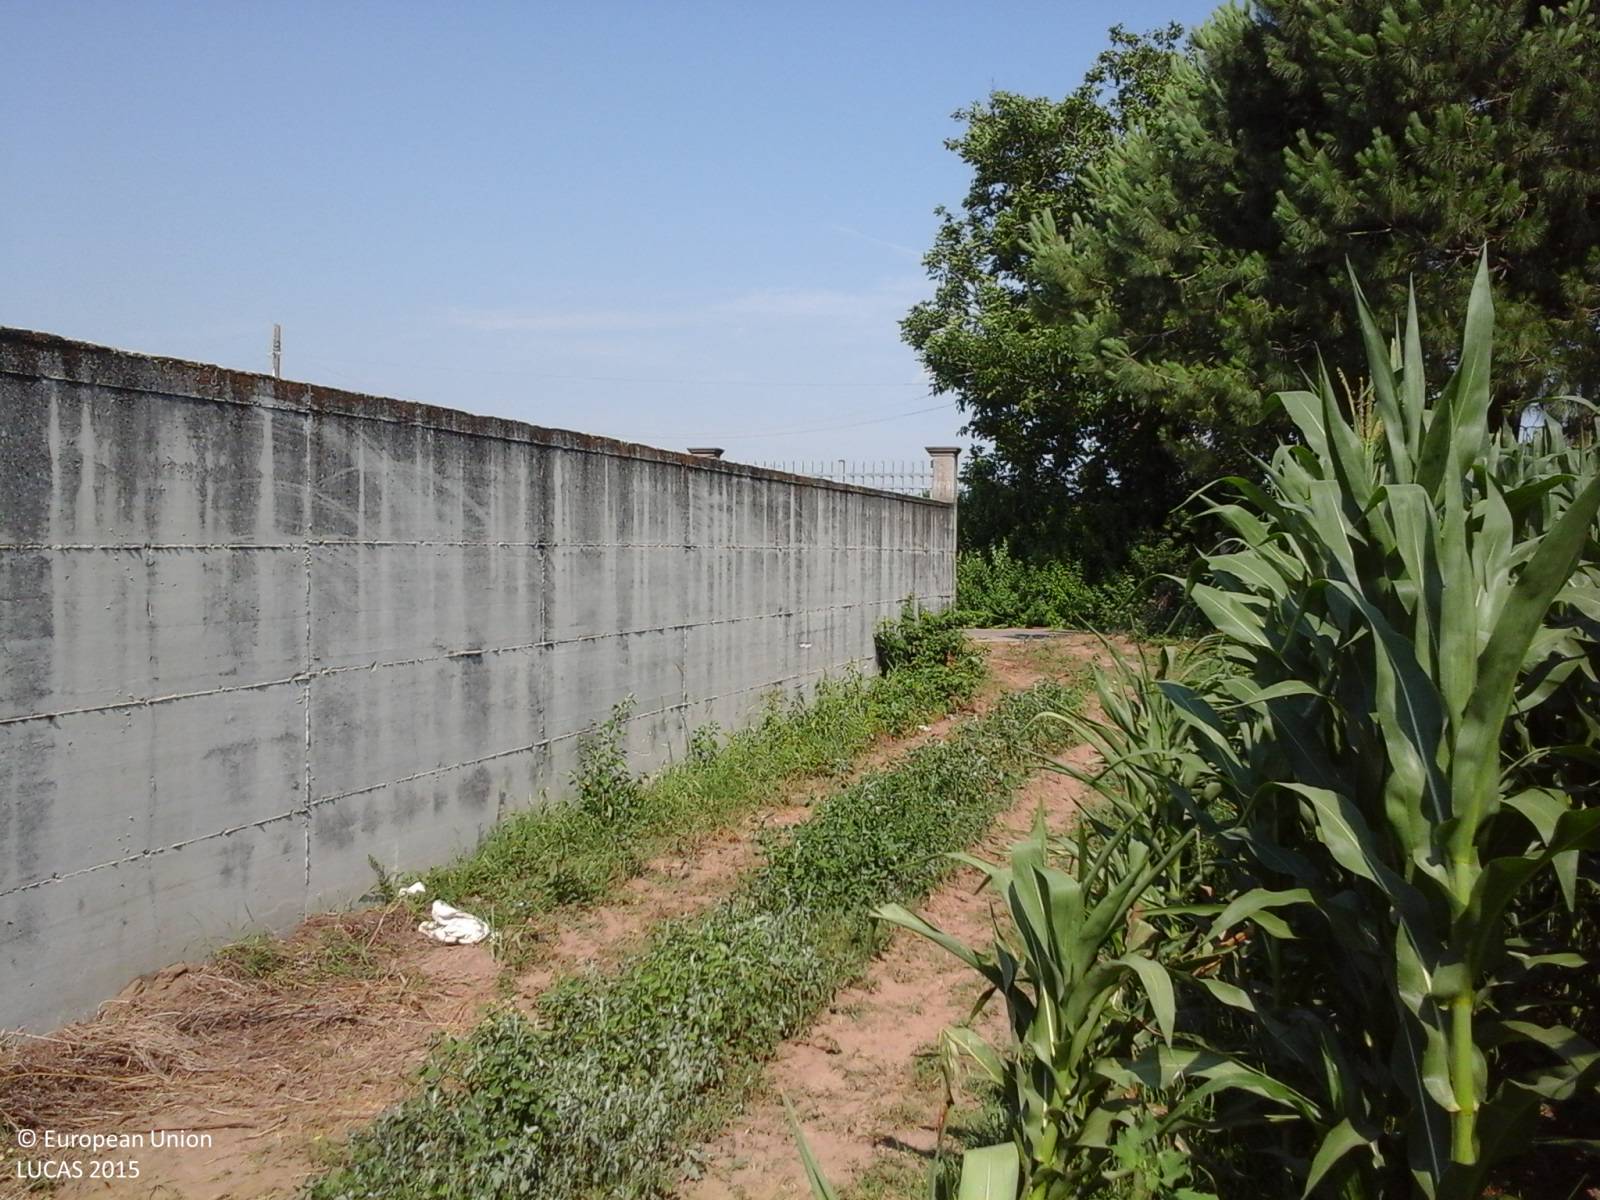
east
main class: Cropland
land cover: Maize
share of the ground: > 75 %
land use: Agriculture (excluding fallow land and kitchen gardens)
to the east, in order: Maize; Abandoned hedges; Fences; Paved roads, cycling and walking lanes; Abandoned hedges; Artificial constructions in urban areas; Other fresh vegetables; Abandoned hedges; Fences; Paved roads, cycling and walking lanes; Abandoned hedges; Fences; Tomatoes
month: July
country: IT
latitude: 41.0125
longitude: 14.1567
